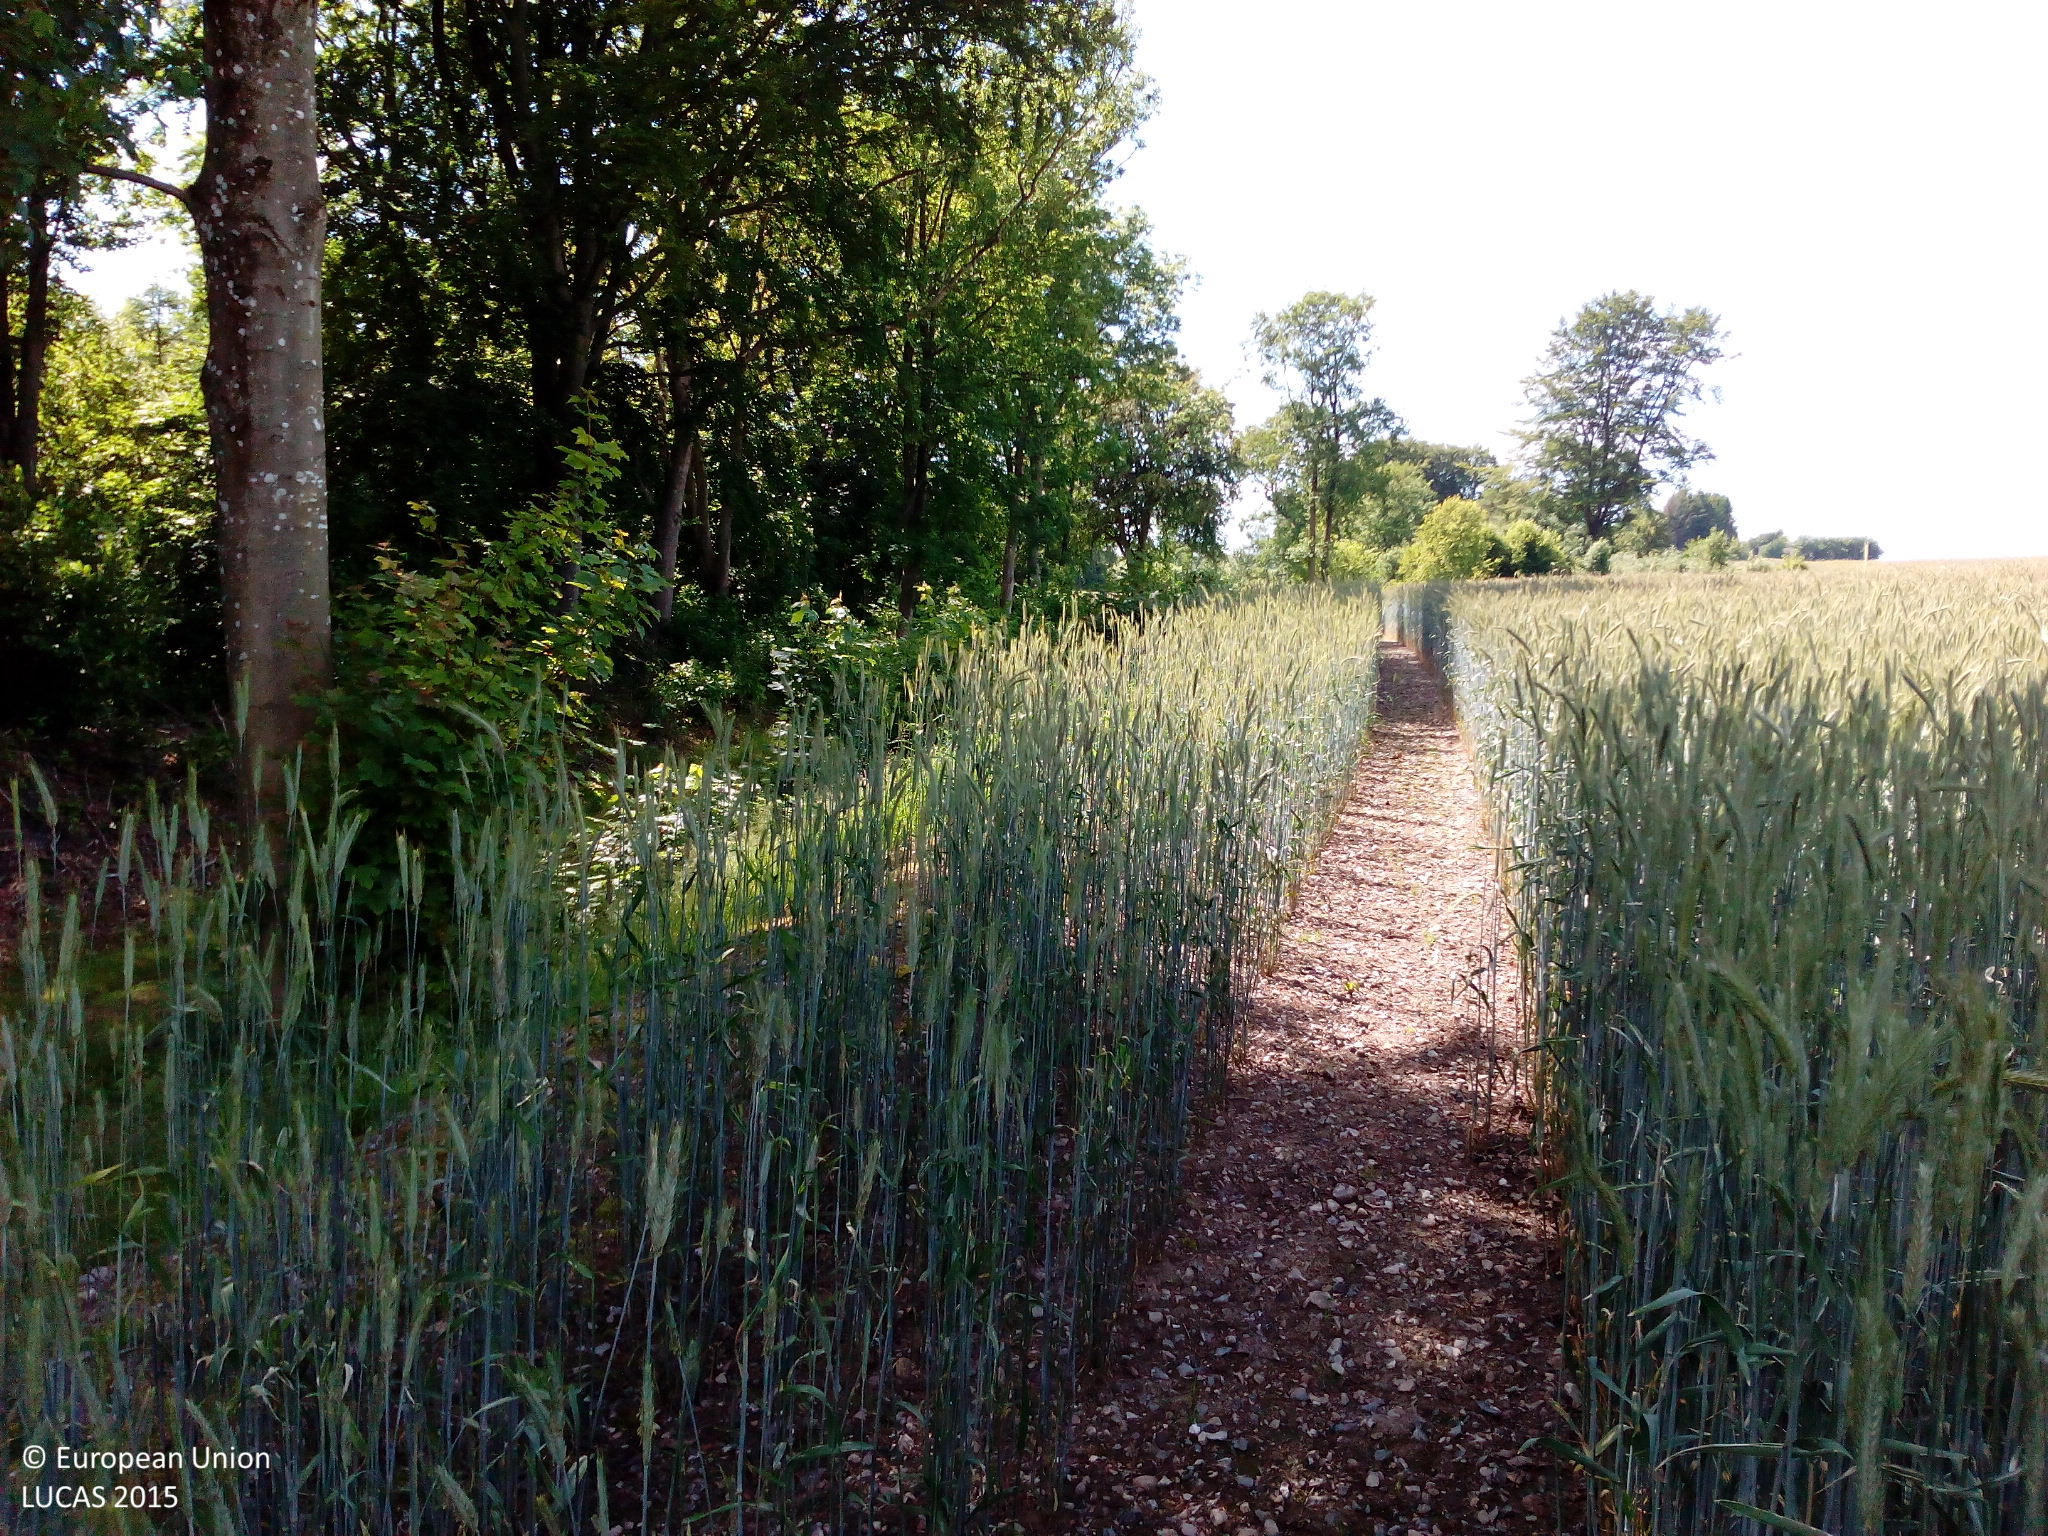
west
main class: Cropland
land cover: Rye
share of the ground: > 75 %
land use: Agriculture (excluding fallow land and kitchen gardens)
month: June
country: DK
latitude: 56.3291
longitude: 10.7915
